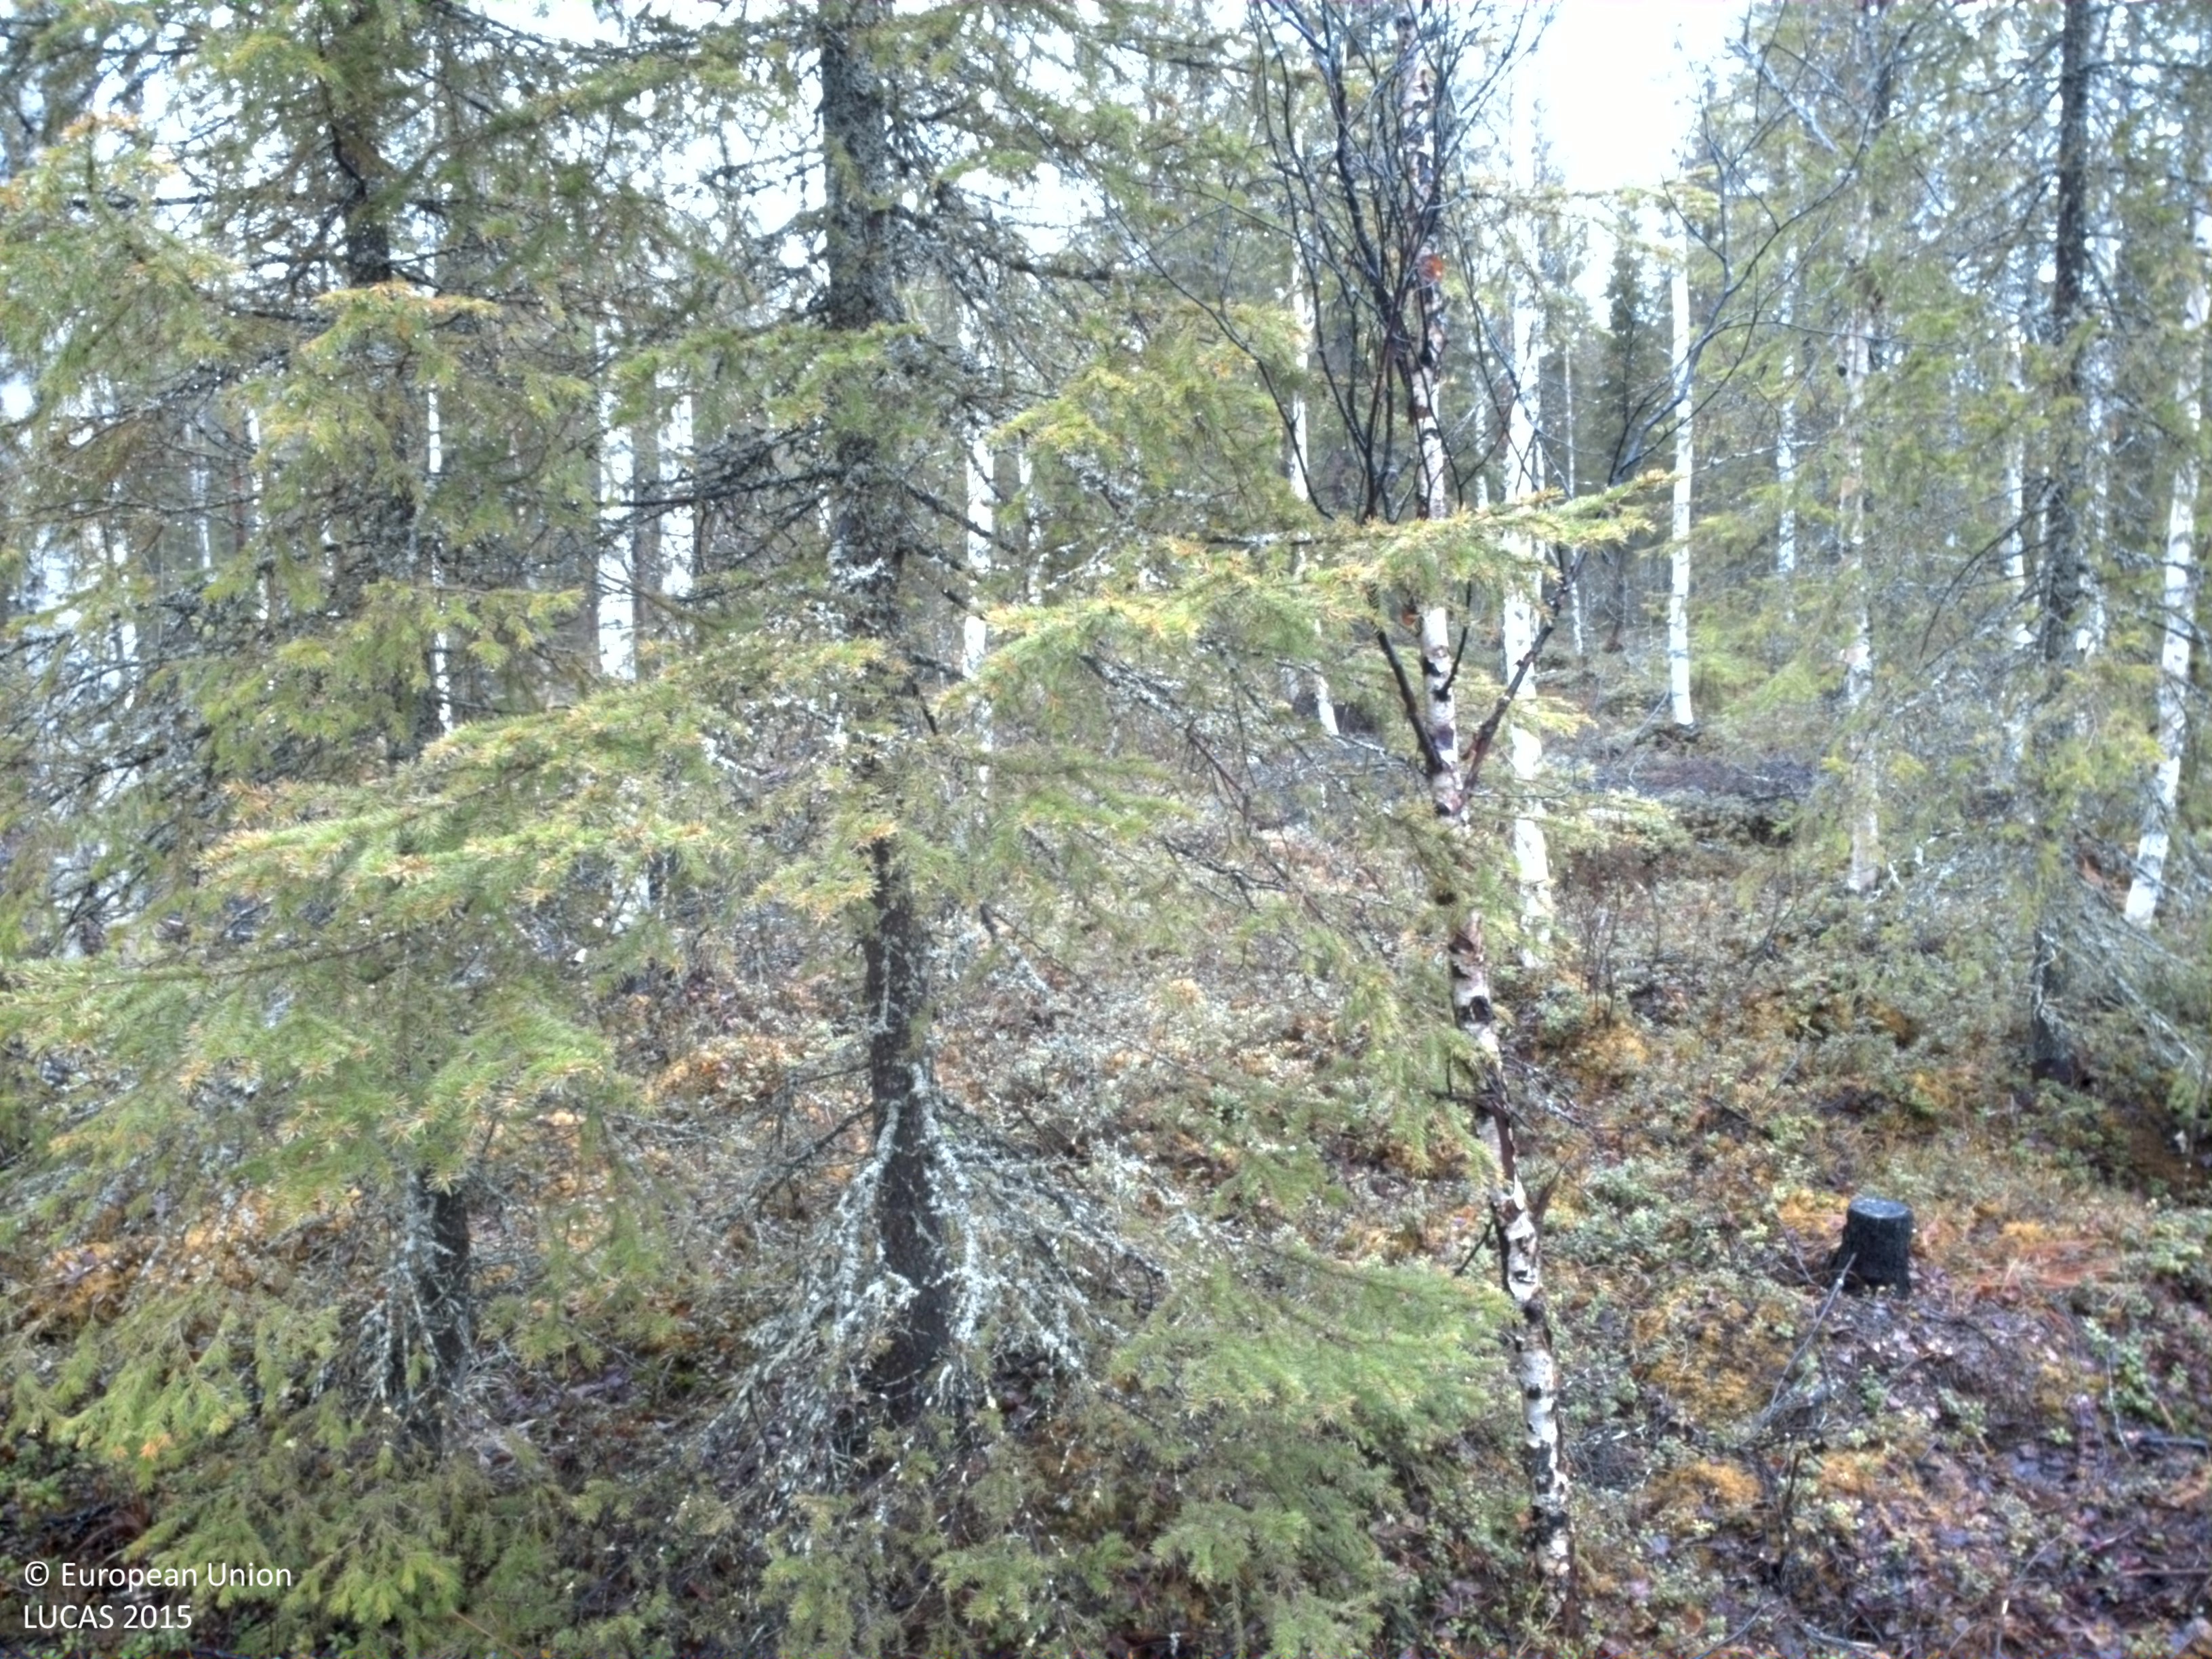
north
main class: Woodland
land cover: Spruce dominated mixed woodland
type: boreal forest
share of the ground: 50 - 75 %
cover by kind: coniferous forest trees 45 %, shrubs 25 %, broadleaved forest trees 15 %, lichens and mosses 15 %
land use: Forestry
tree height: > 5 m
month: May
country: SE
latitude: 66.5262
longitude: 23.2311
